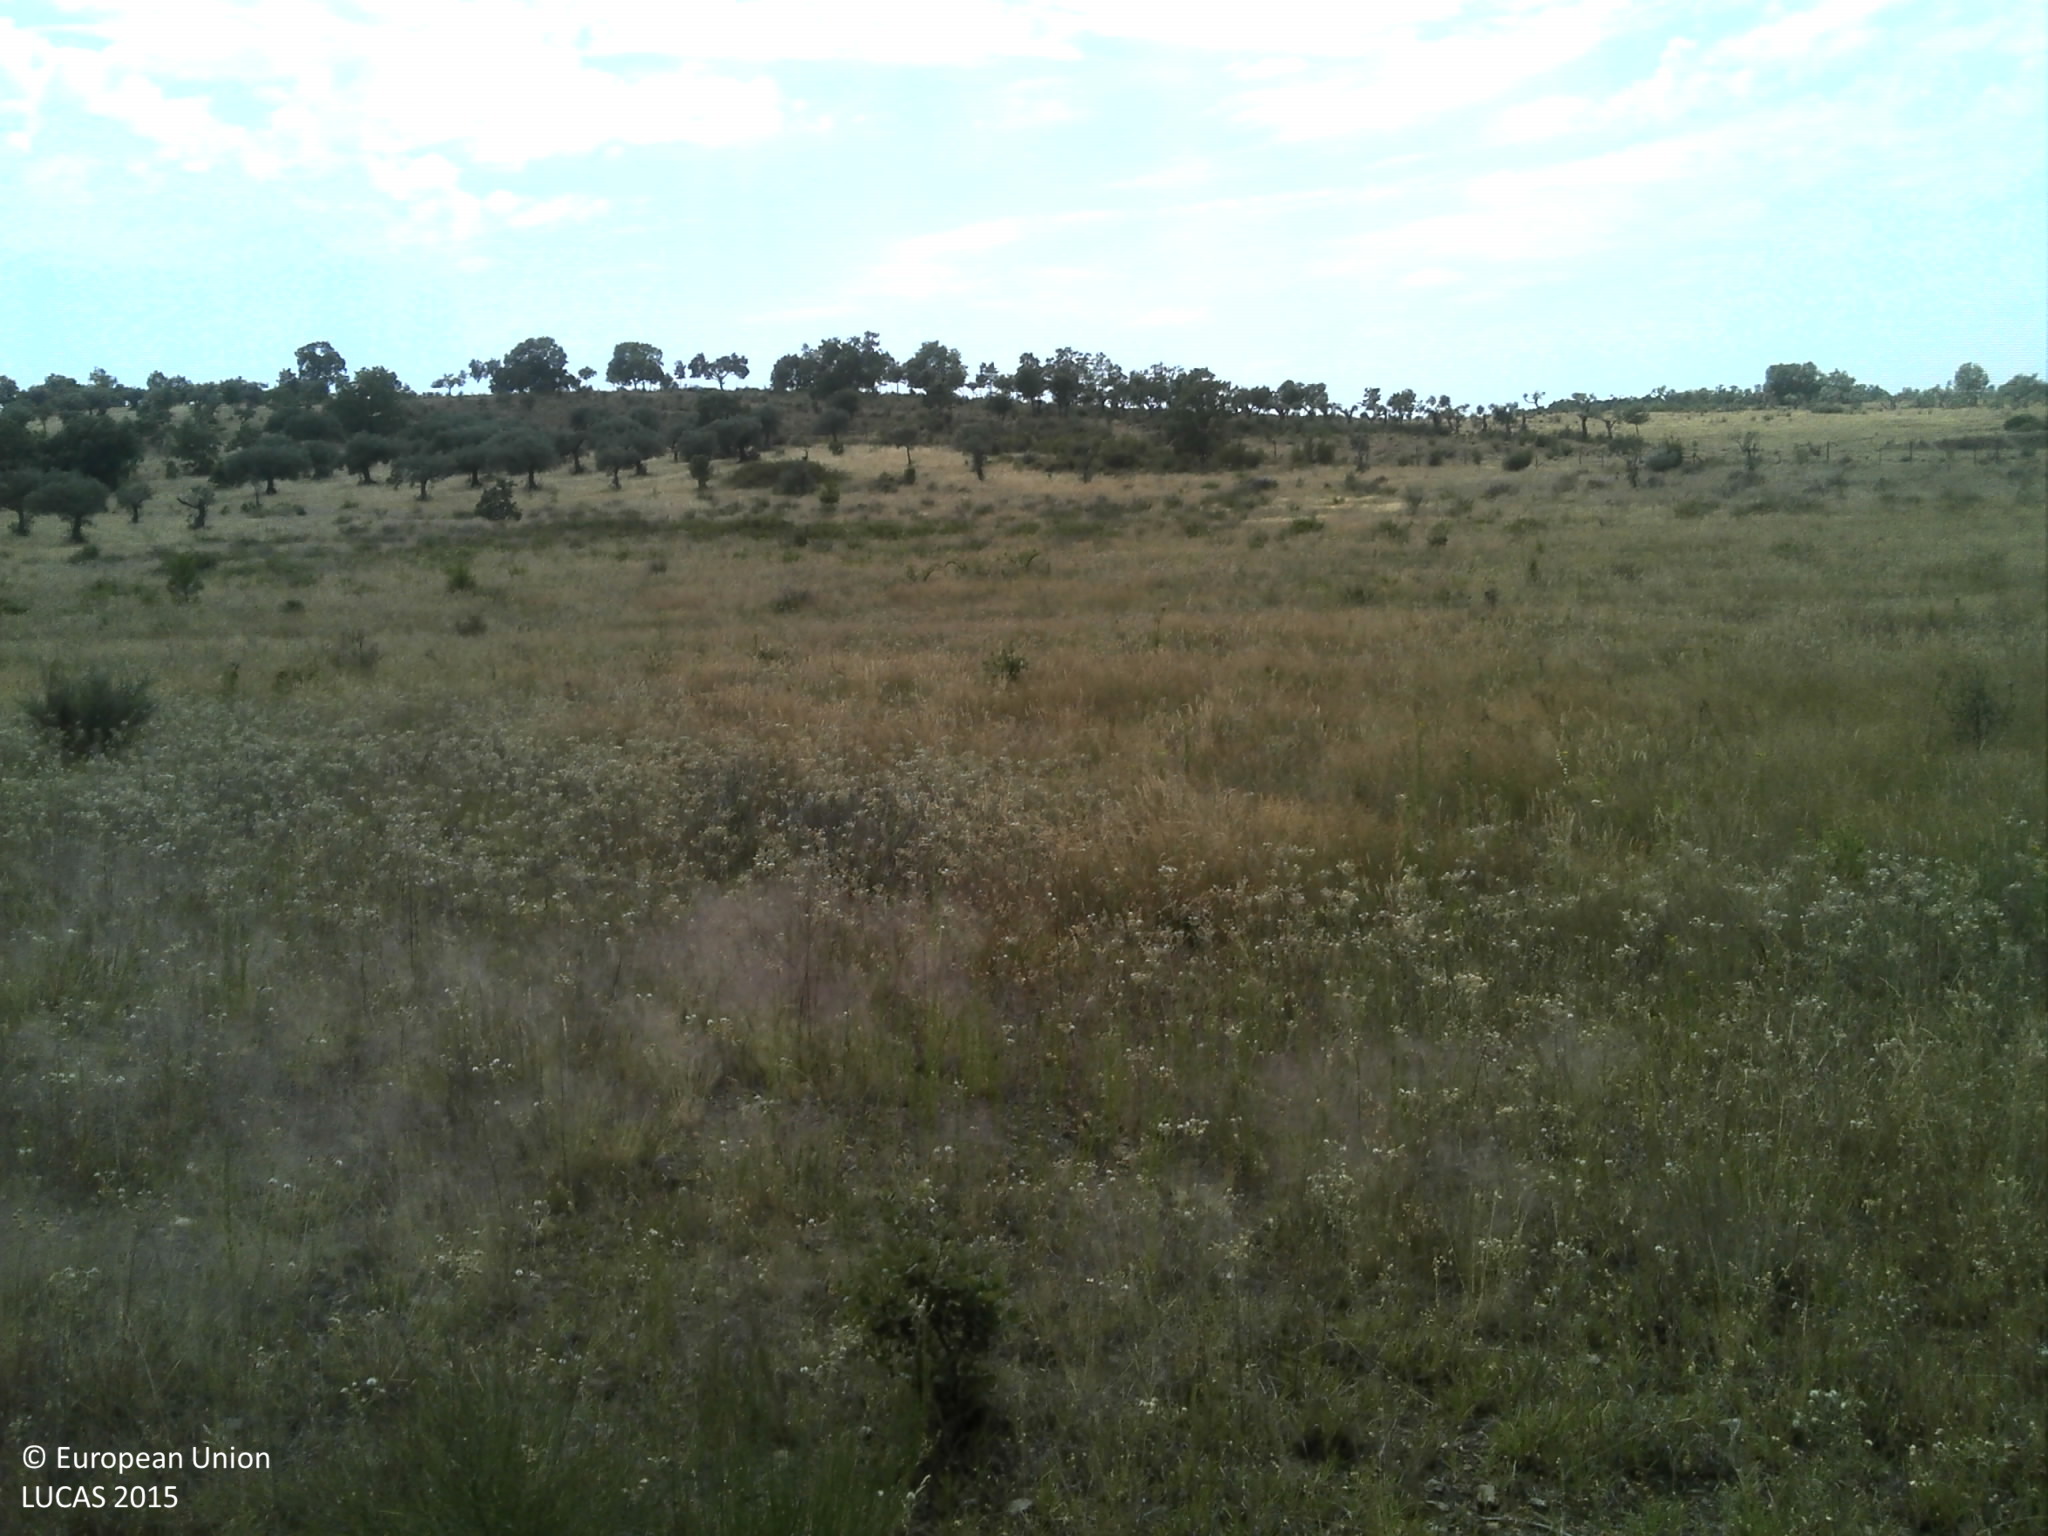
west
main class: Woodland
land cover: Broadleaved woodland
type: broadleaved evergreen forest
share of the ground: 50 - 75 %
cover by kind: broadleaved forest trees 65 %, shrubs 25 %, unconsolidated bare surface 5 %
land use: Forestry
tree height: > 5 m
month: June
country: PT
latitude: 40.1499
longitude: -7.1293
